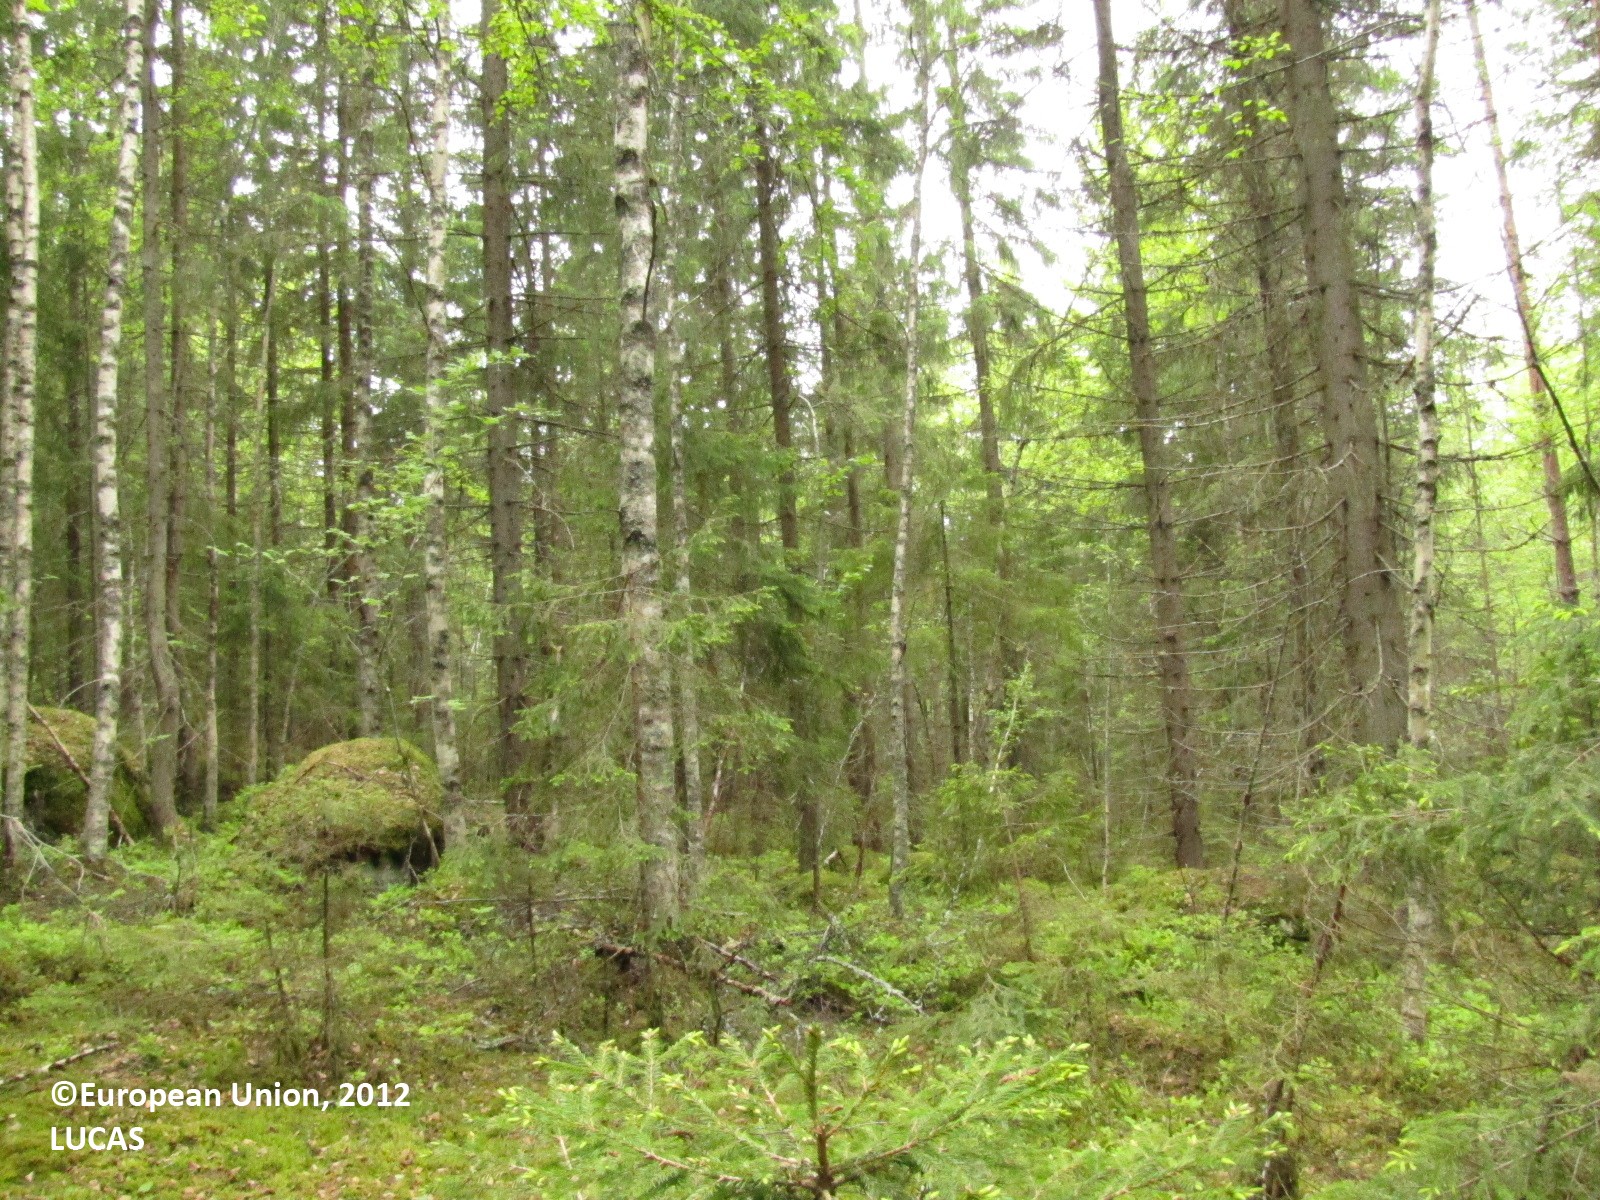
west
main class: Woodland
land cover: Spruce dominated mixed woodland
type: hemiboreal forest and nemoral coniferous forest and mixed broadleaved-coniferous forest
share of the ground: 50 - 75 %
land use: Forestry
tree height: > 5 m
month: June
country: FI
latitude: 61.4886
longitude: 23.0870
